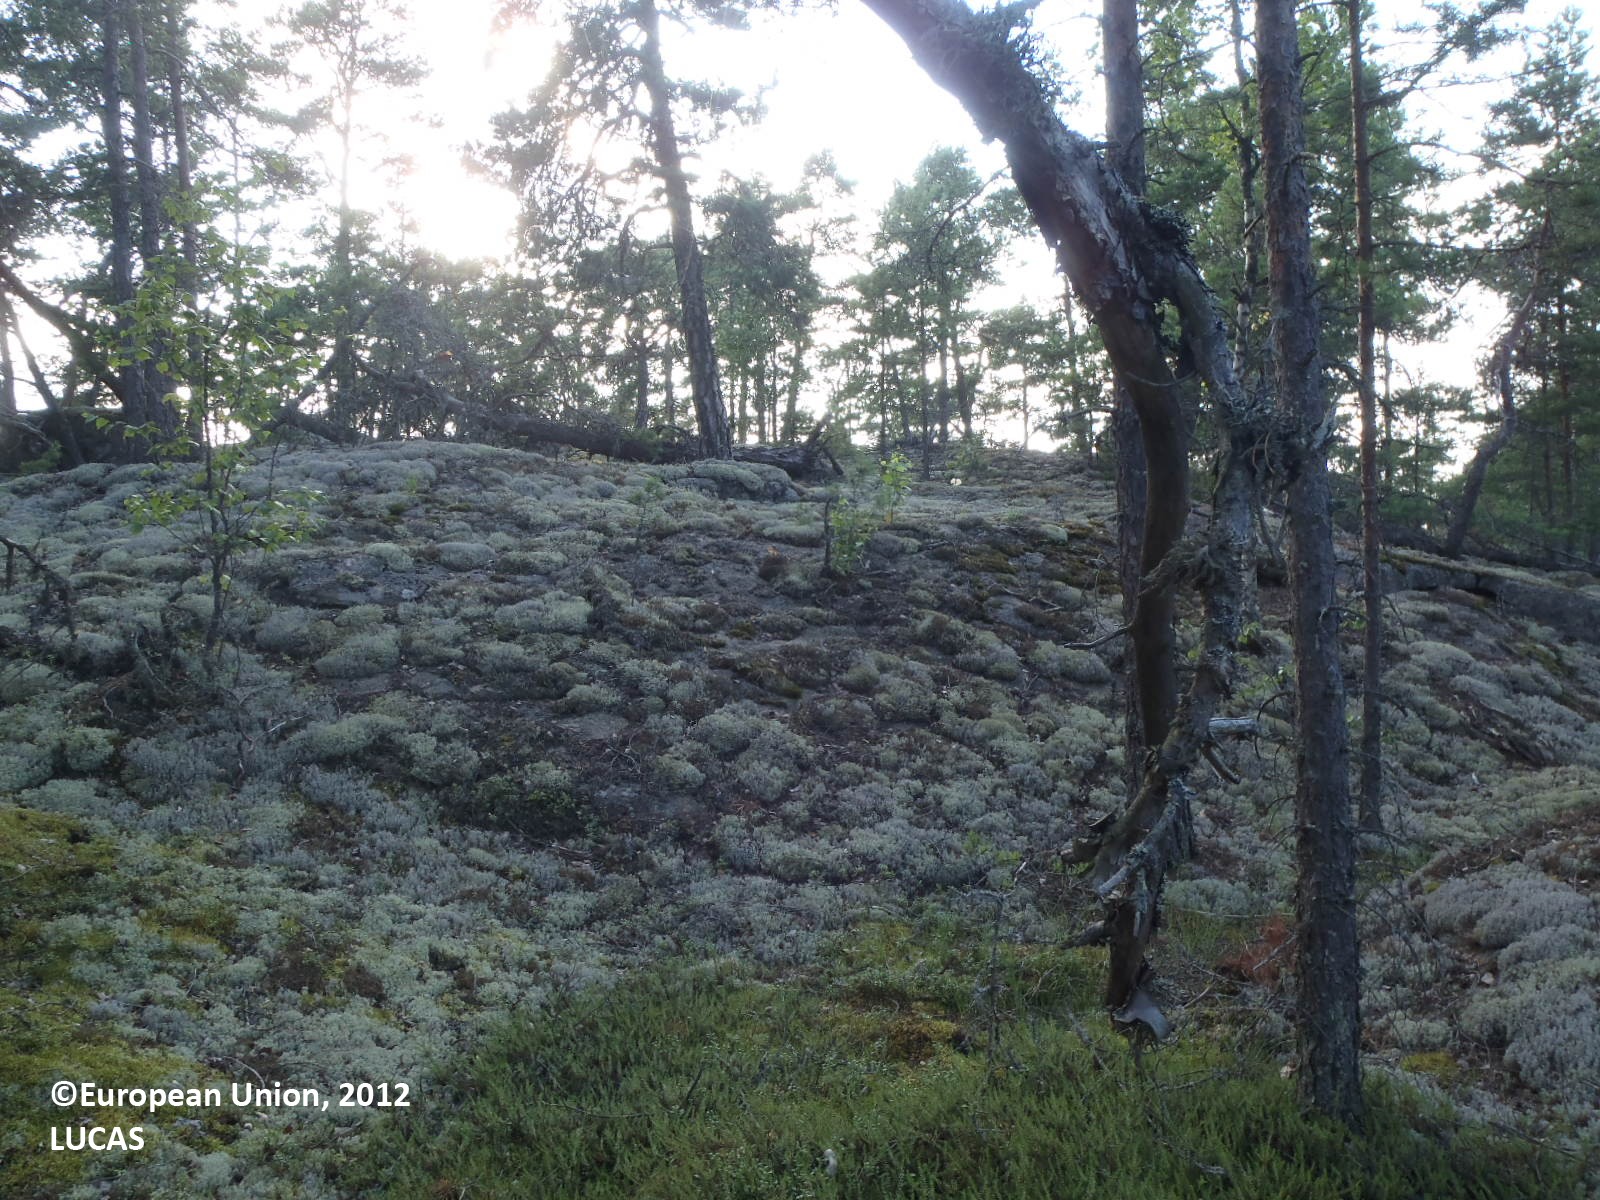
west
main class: Woodland
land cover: Pine dominated coniferous woodland
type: boreal forest
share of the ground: 50 - 75 %
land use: Semi-natural and natural areas not in use
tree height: > 5 m
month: July
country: FI
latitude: 60.5509
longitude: 21.6737
